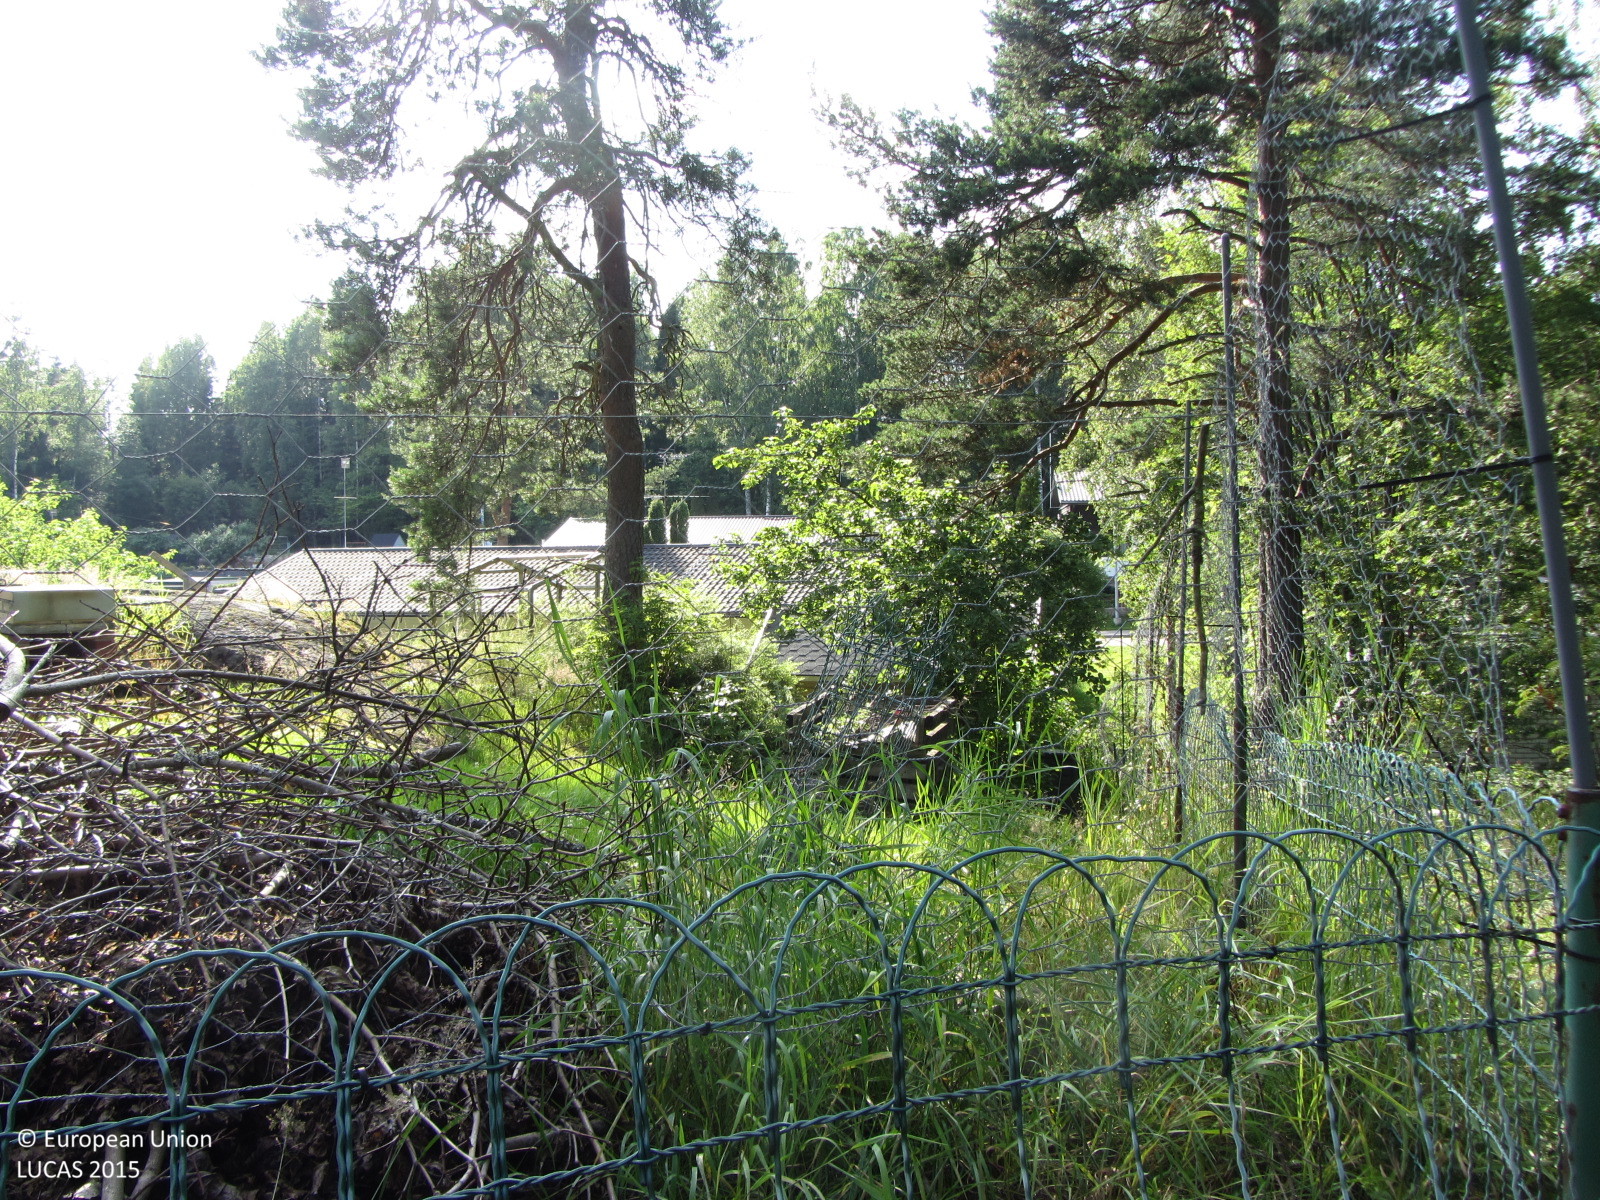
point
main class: Grassland
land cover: Grassland with sparse tree/shrub cover
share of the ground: > 75 %
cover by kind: herbaceous plants 85 %, shrubs 10 %, coniferous forest trees 5 %
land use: Residential
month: July
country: FI
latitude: 60.0963
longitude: 24.4032
